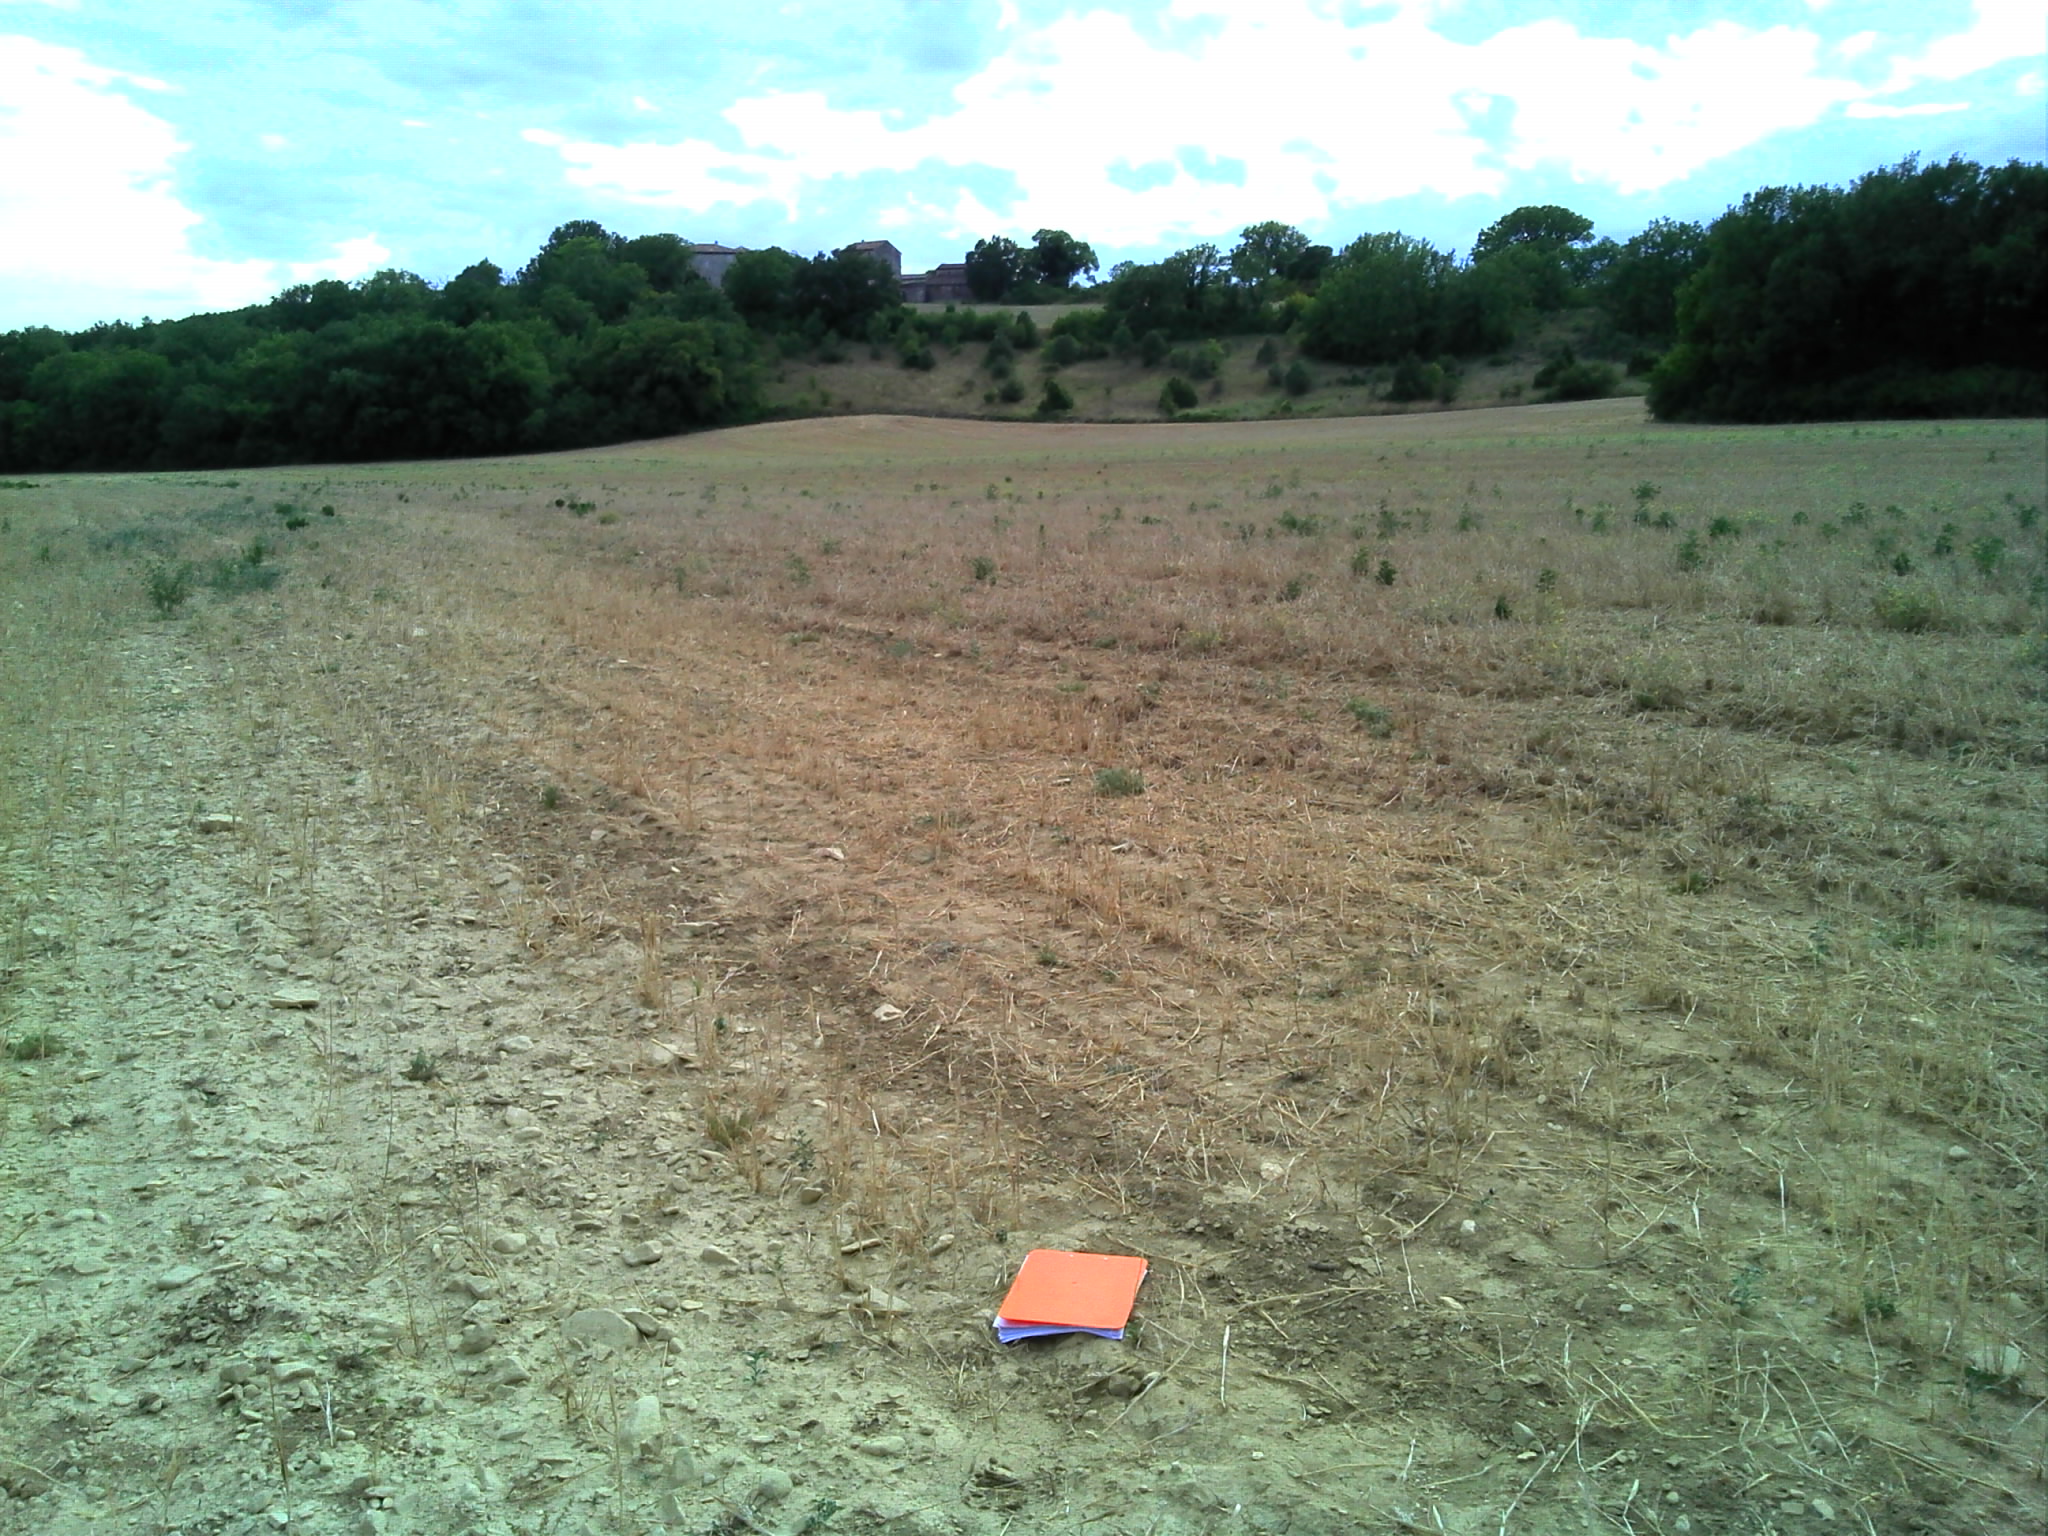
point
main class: Cropland
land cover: Barley
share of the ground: 10 - 25 %
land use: Agriculture (excluding fallow land and kitchen gardens)
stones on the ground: < 10 %
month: July
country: FR
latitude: 44.2859
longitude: 4.3306
